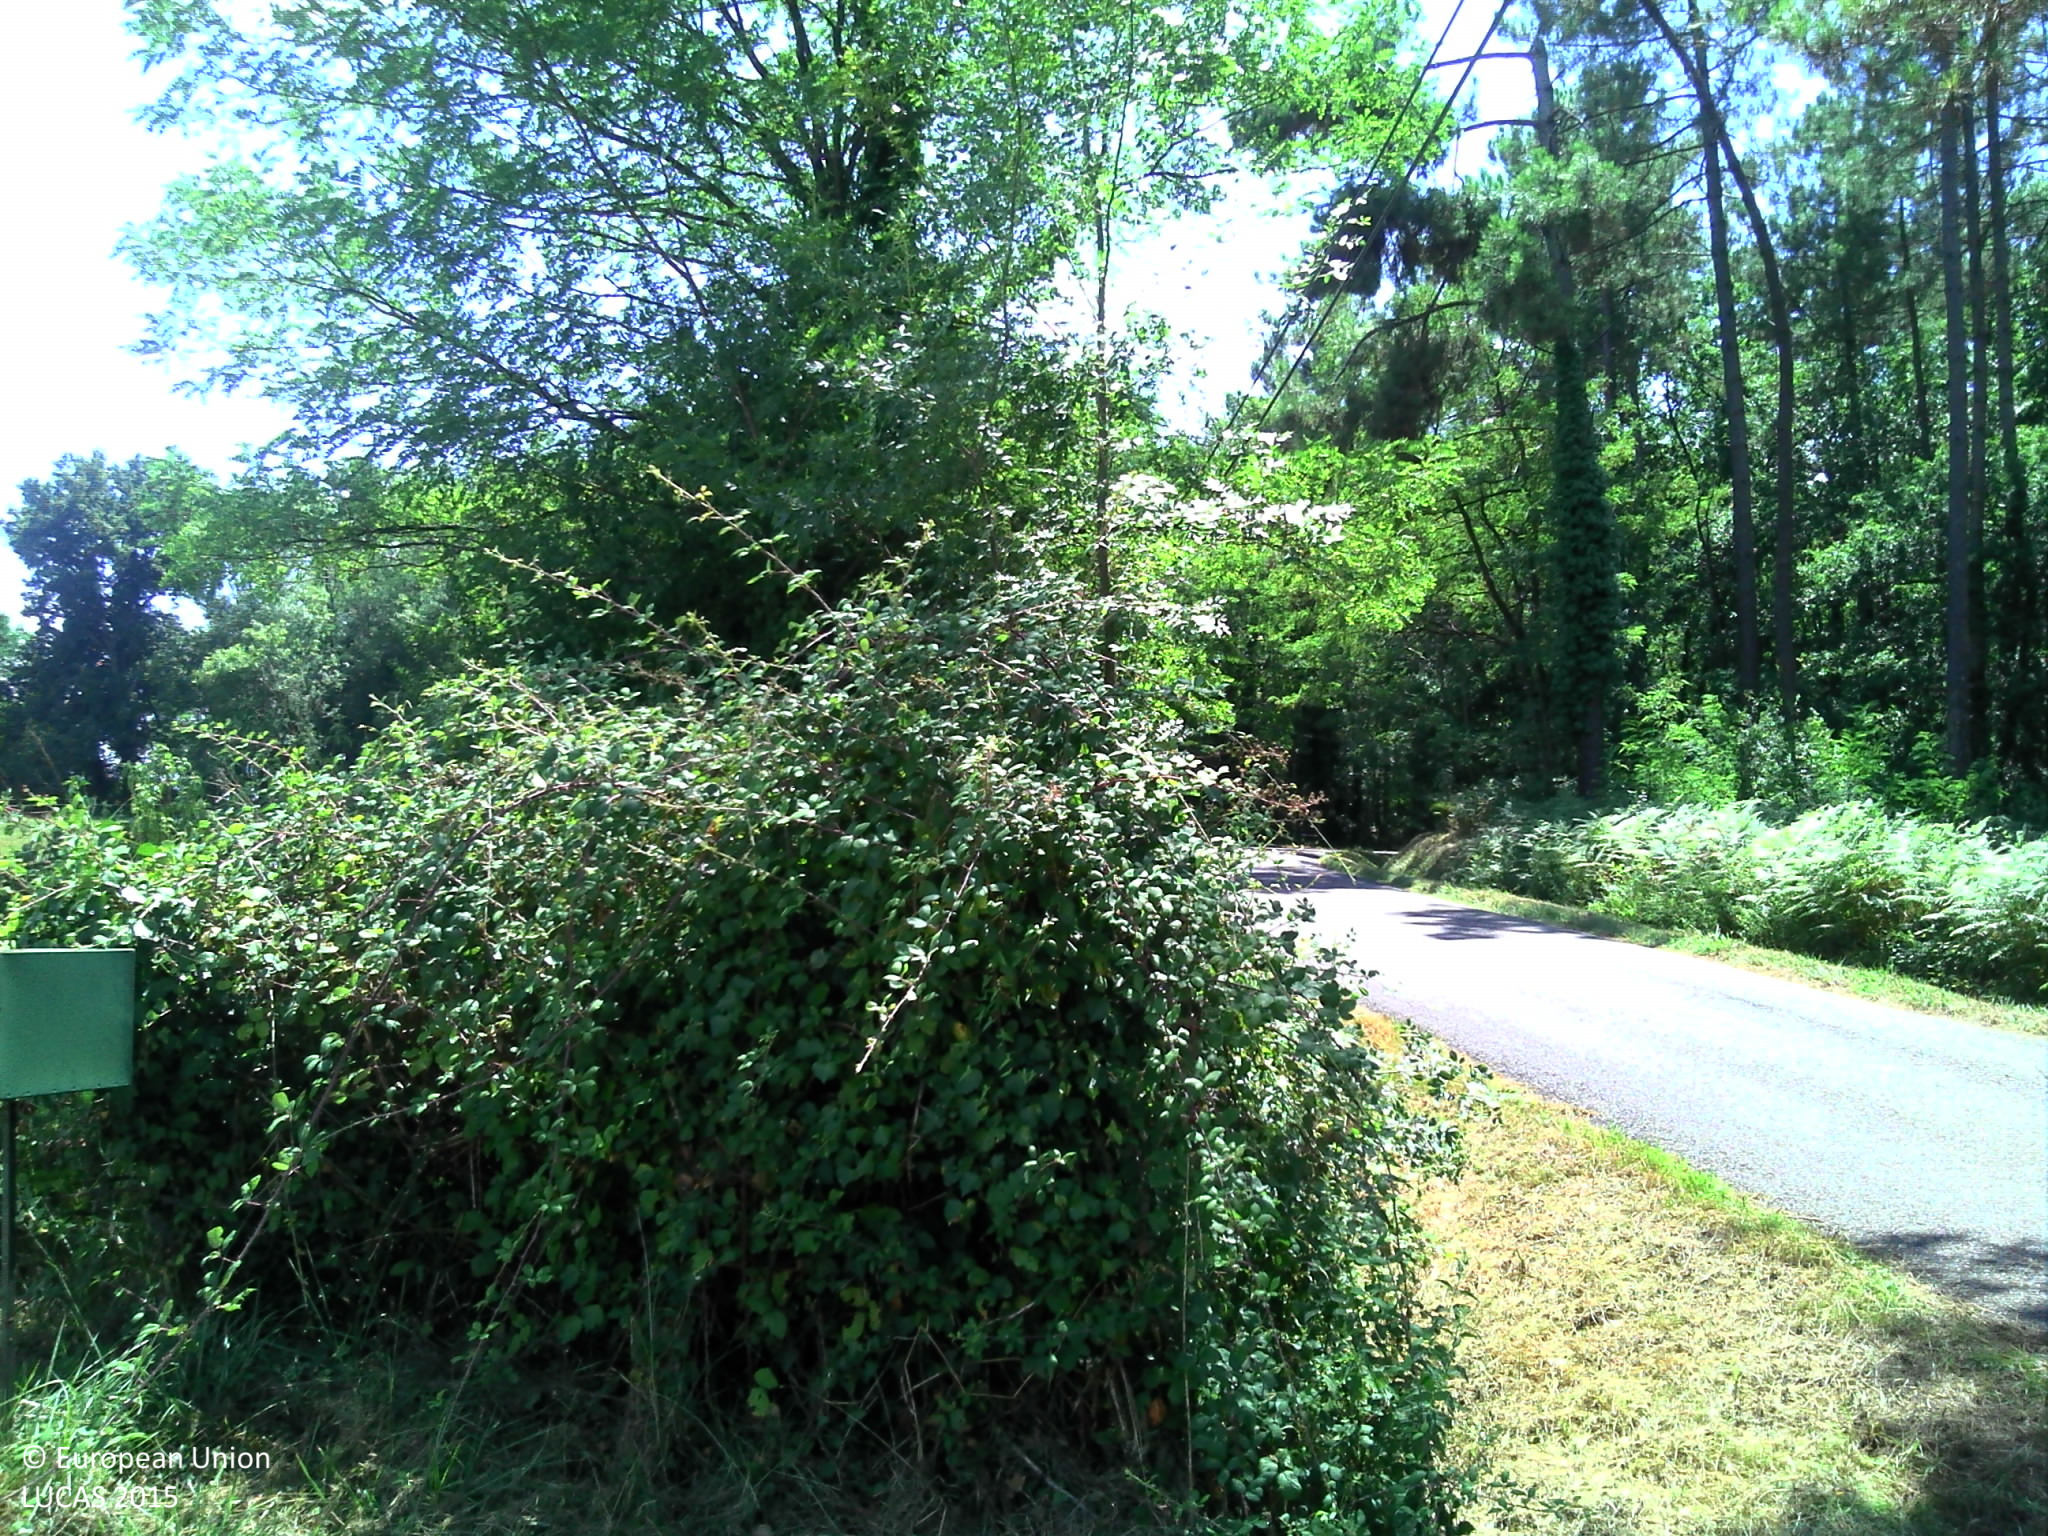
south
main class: Grassland
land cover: Grassland without tree/shrub cover
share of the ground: > 75 %
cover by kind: herbaceous plants 100 %
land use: Agriculture (excluding fallow land and kitchen gardens)
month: July
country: FR
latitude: 43.8682
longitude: -0.5266
